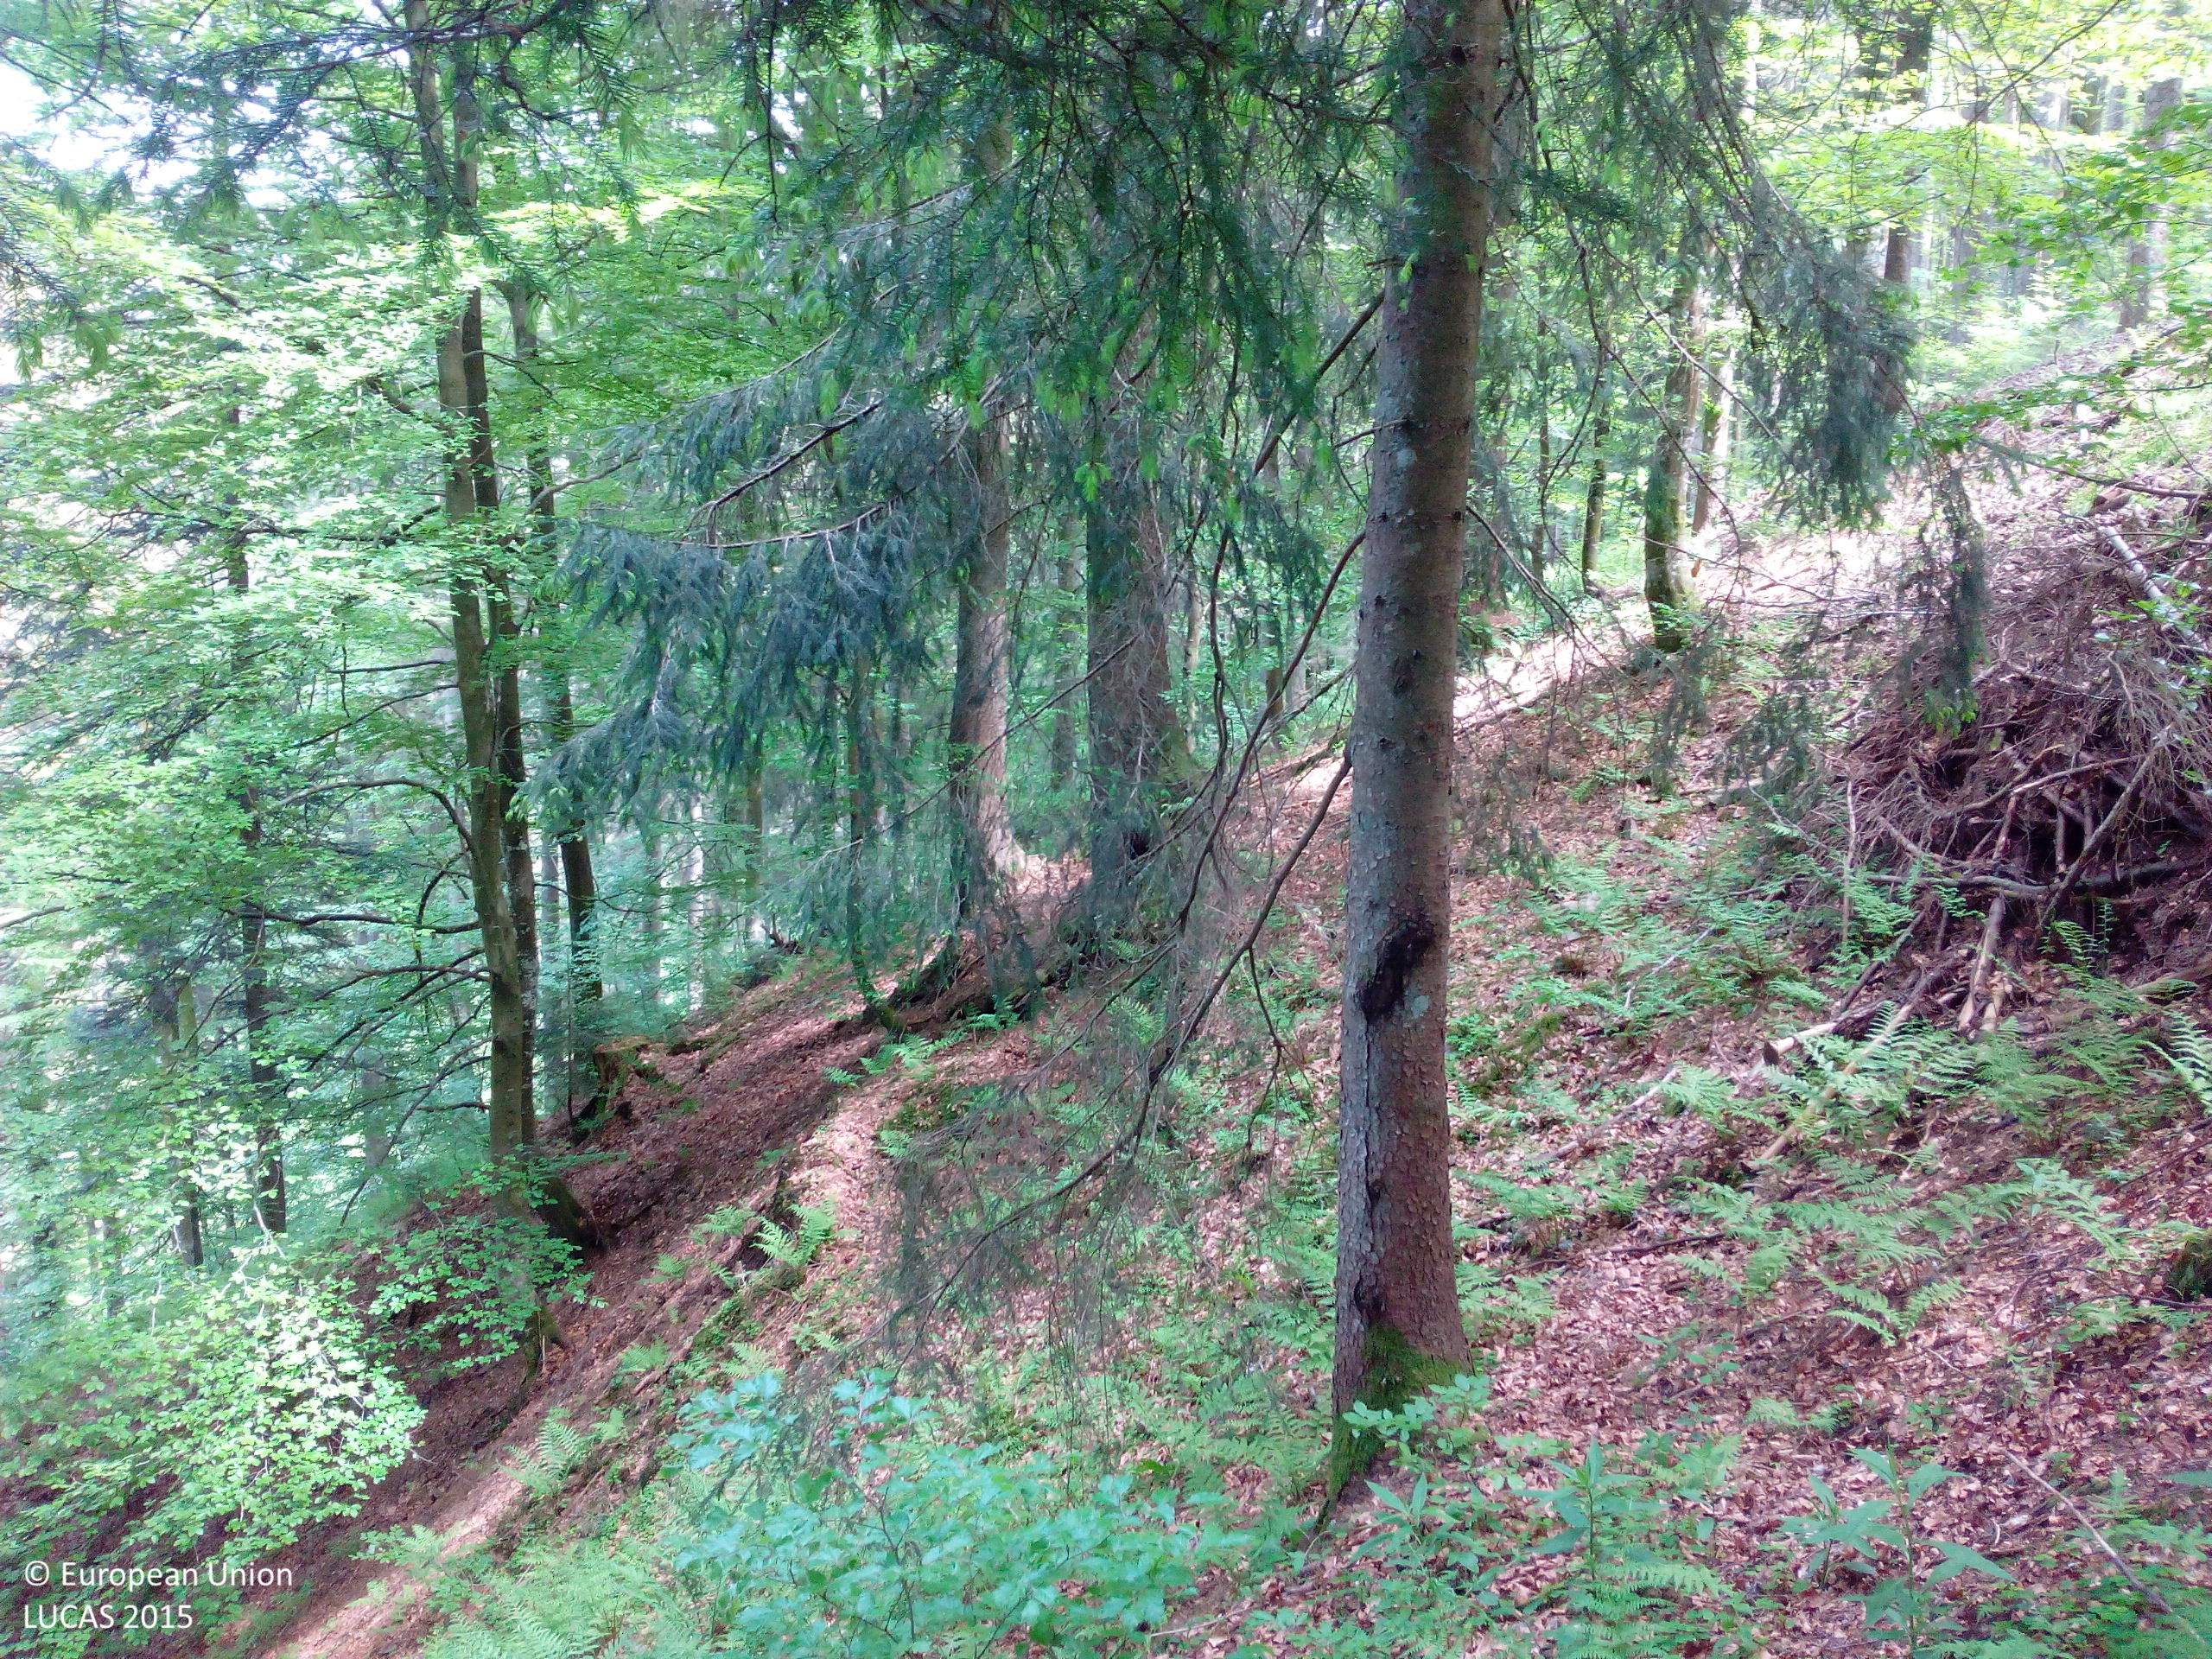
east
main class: Woodland
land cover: Other mixed woodland
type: hemiboreal forest and nemoral coniferous forest and mixed broadleaved-coniferous forest
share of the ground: > 75 %
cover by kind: coniferous forest trees 75 %, broadleaved forest trees 25 %
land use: Forestry
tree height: > 5 m
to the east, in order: Other mixed woodland; Other coniferous woodland; Spruce dominated mixed woodland; Fences; Grassland without tree/shrub cover
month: May
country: DE
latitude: 48.0107
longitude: 8.1913
